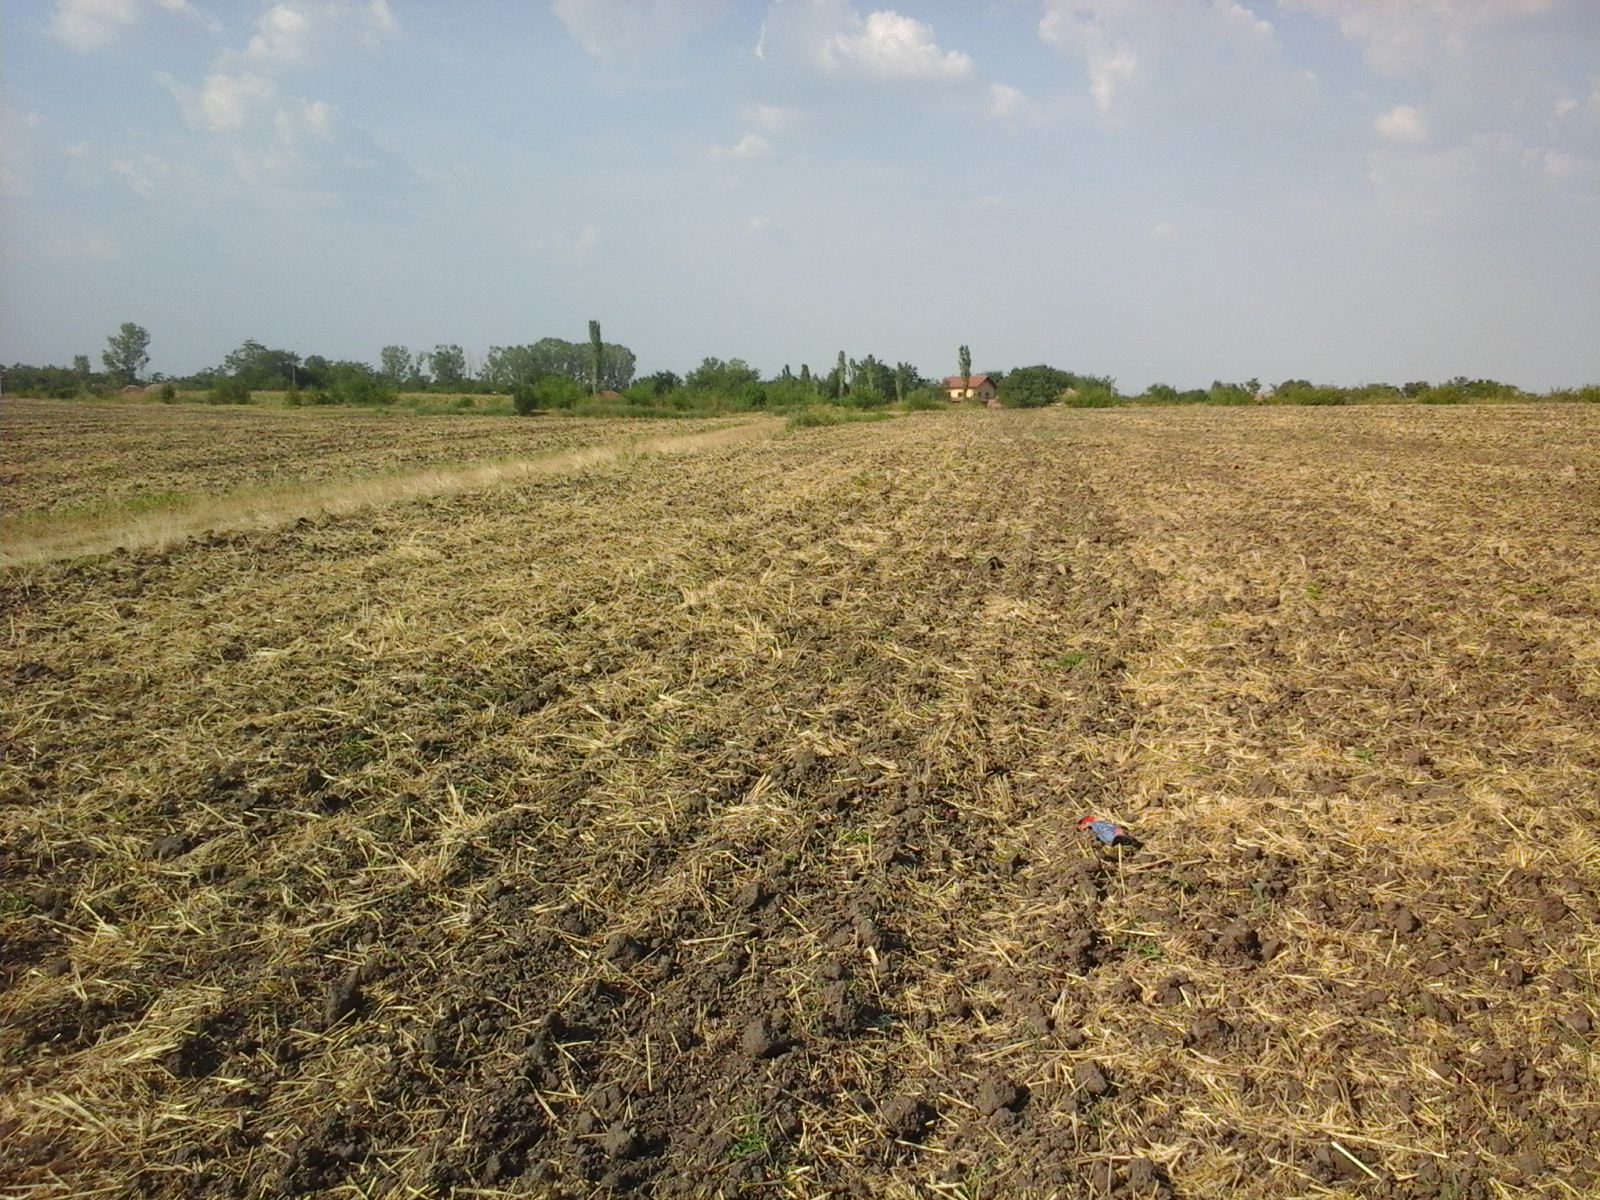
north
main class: Cropland
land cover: Common wheat
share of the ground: 10 - 25 %
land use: Agriculture (excluding fallow land and kitchen gardens)
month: August
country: RO
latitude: 43.9124
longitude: 23.5603
